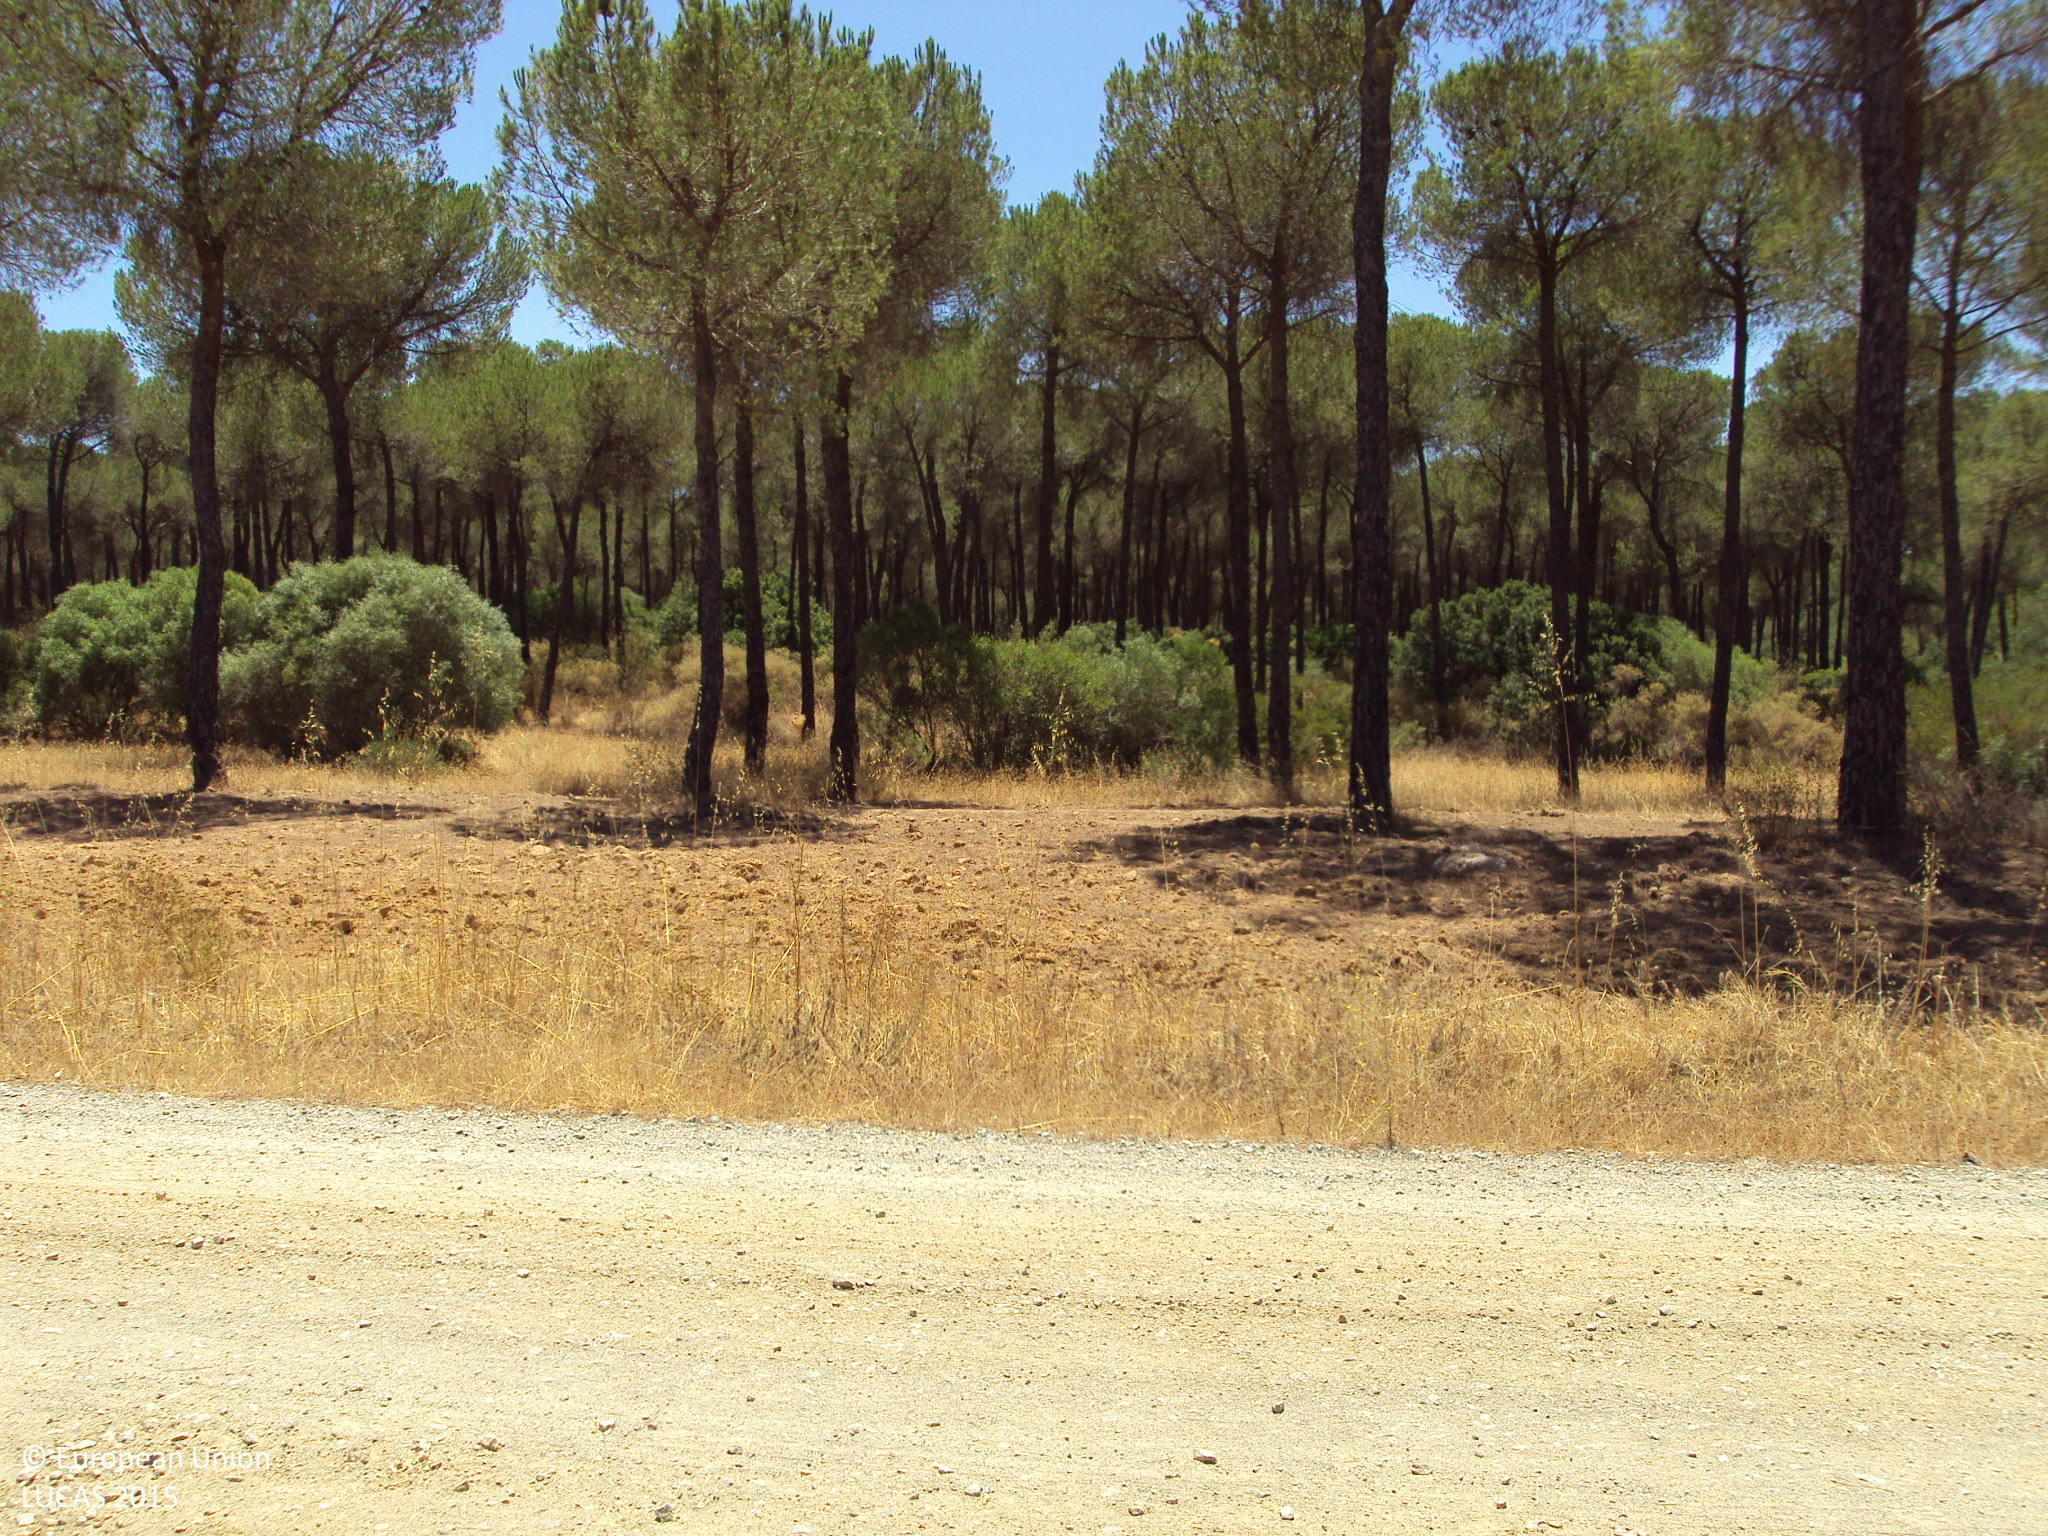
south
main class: Cropland
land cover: Oranges
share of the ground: > 75 %
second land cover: Spontaneously vegetated surfaces
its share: 10 - 25 %
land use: Agriculture (excluding fallow land and kitchen gardens)
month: July
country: ES
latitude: 37.1934
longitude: -6.3269
